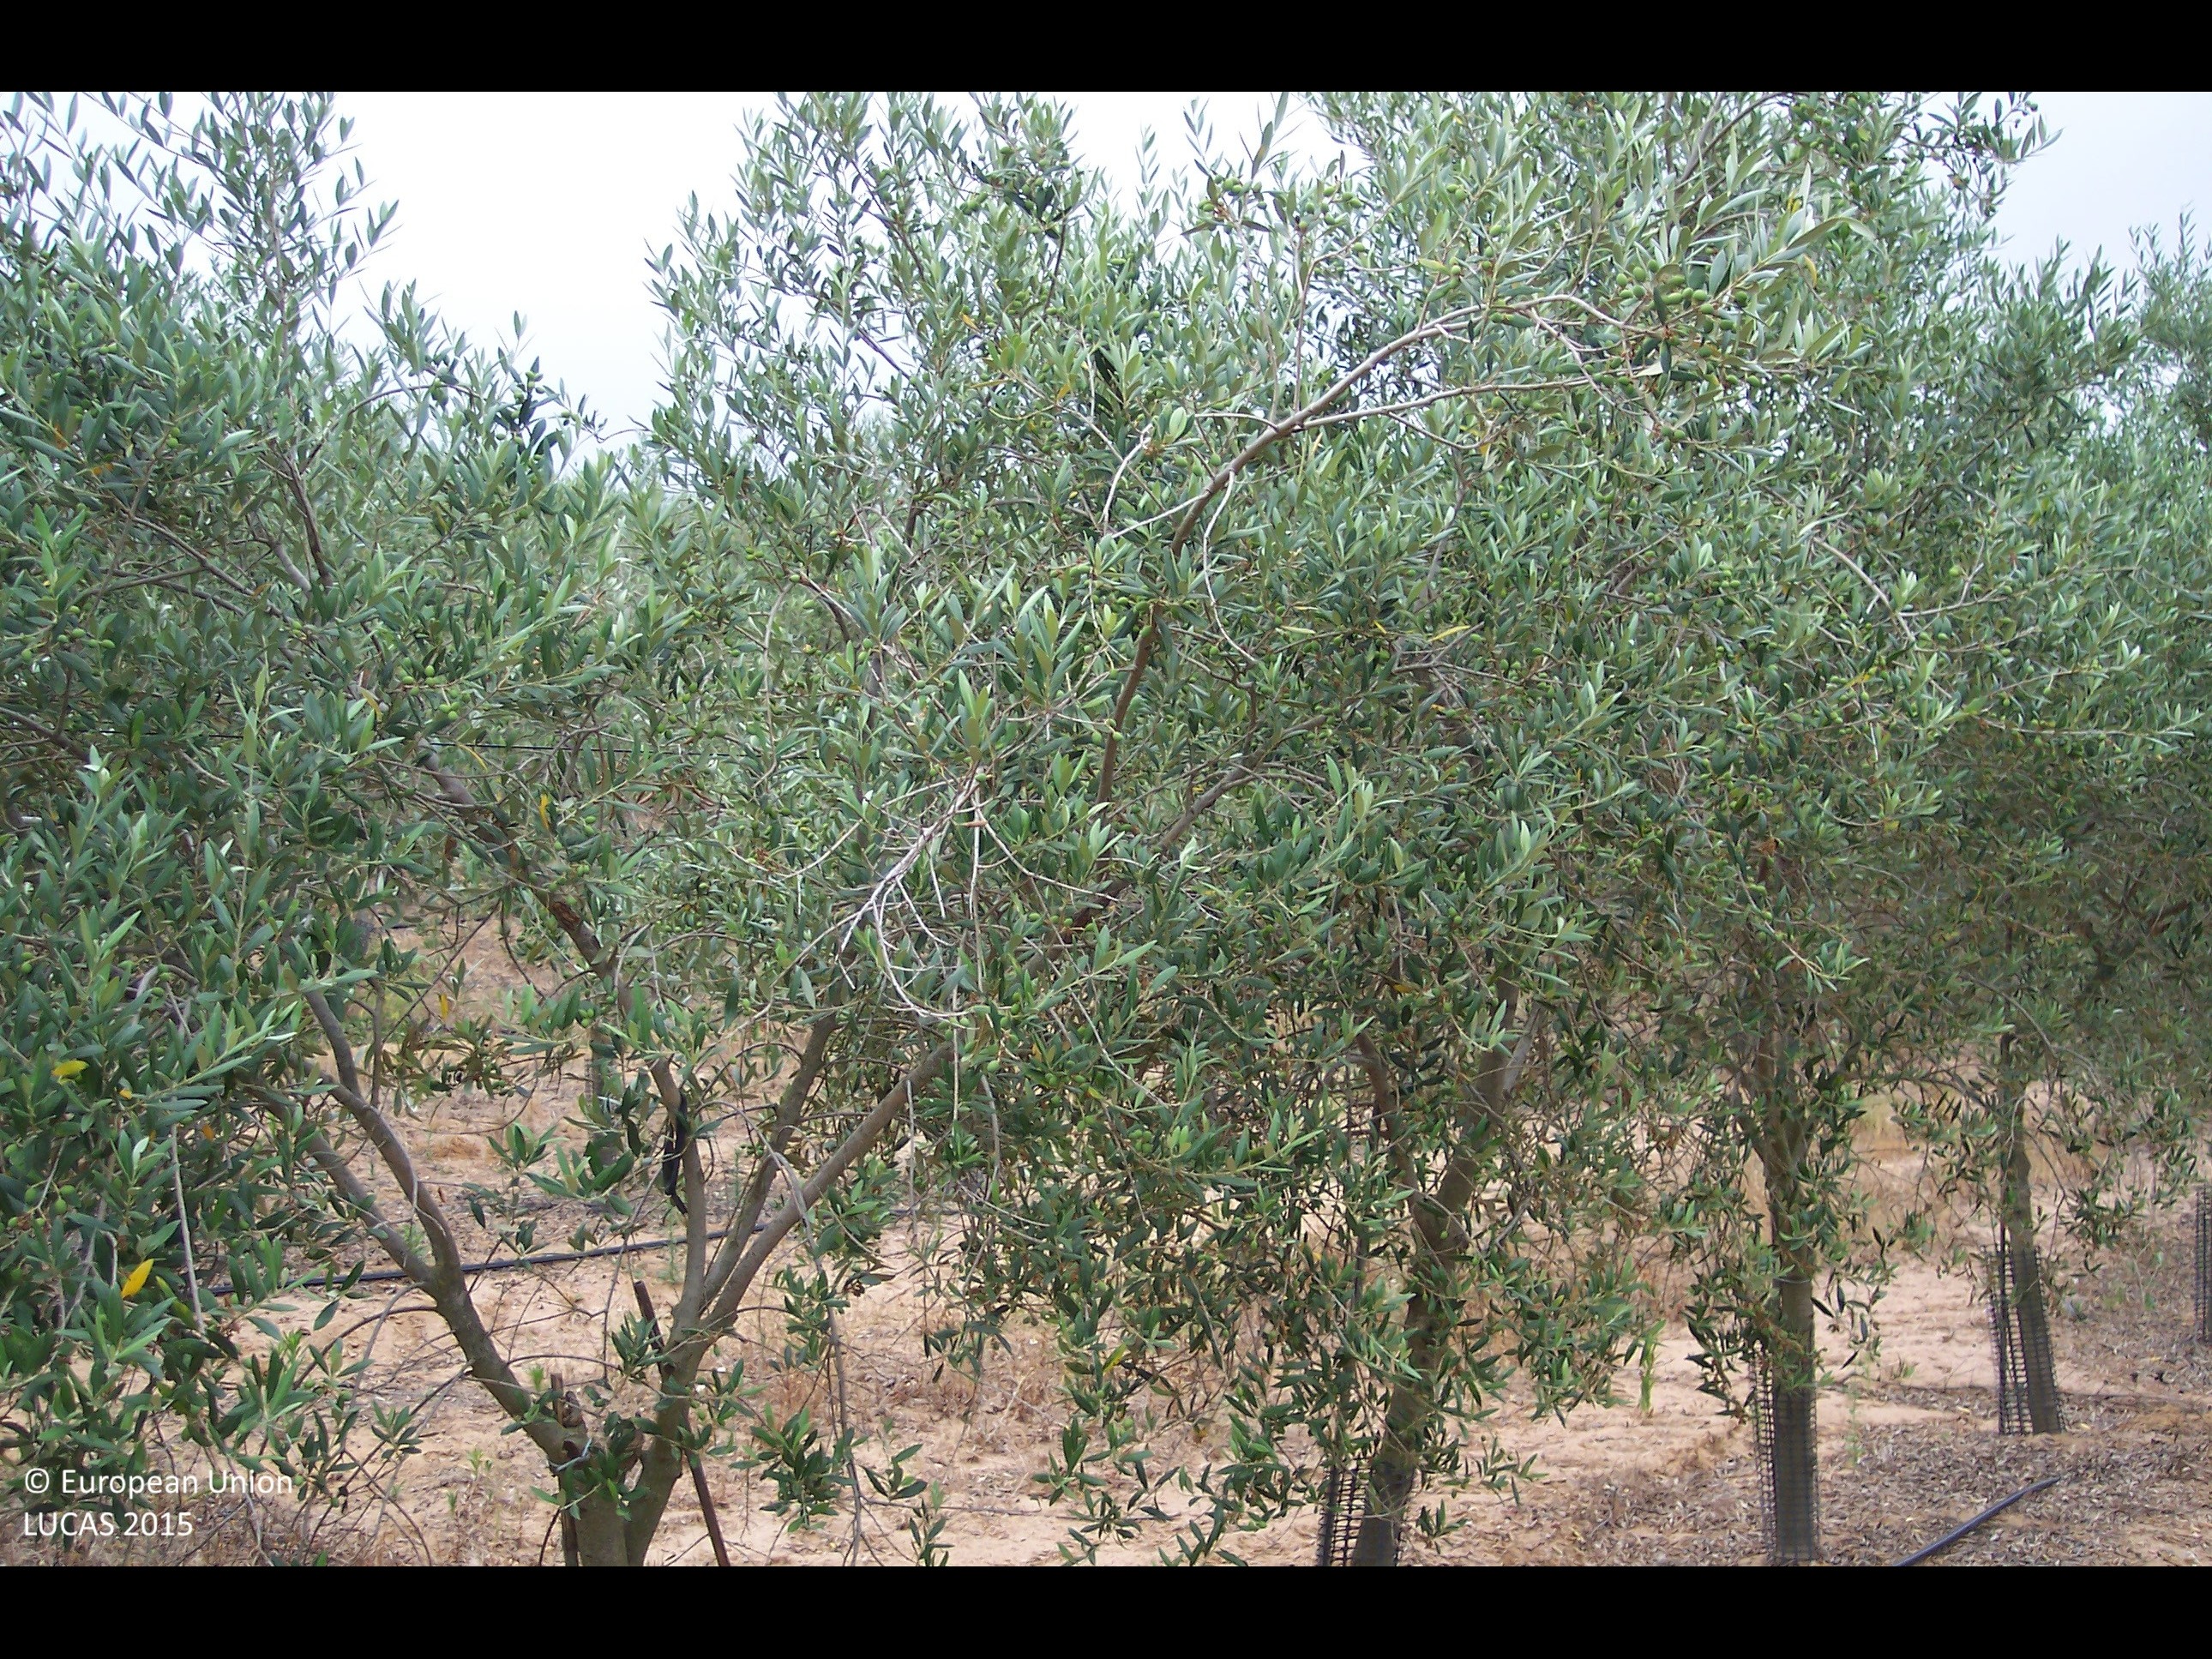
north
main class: Cropland
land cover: Olive groves
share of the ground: 25 - 50 %
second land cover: Spontaneously vegetated surfaces
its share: > 75 %
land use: Agriculture (excluding fallow land and kitchen gardens)
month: June
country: ES
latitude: 37.2810
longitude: -6.1413
